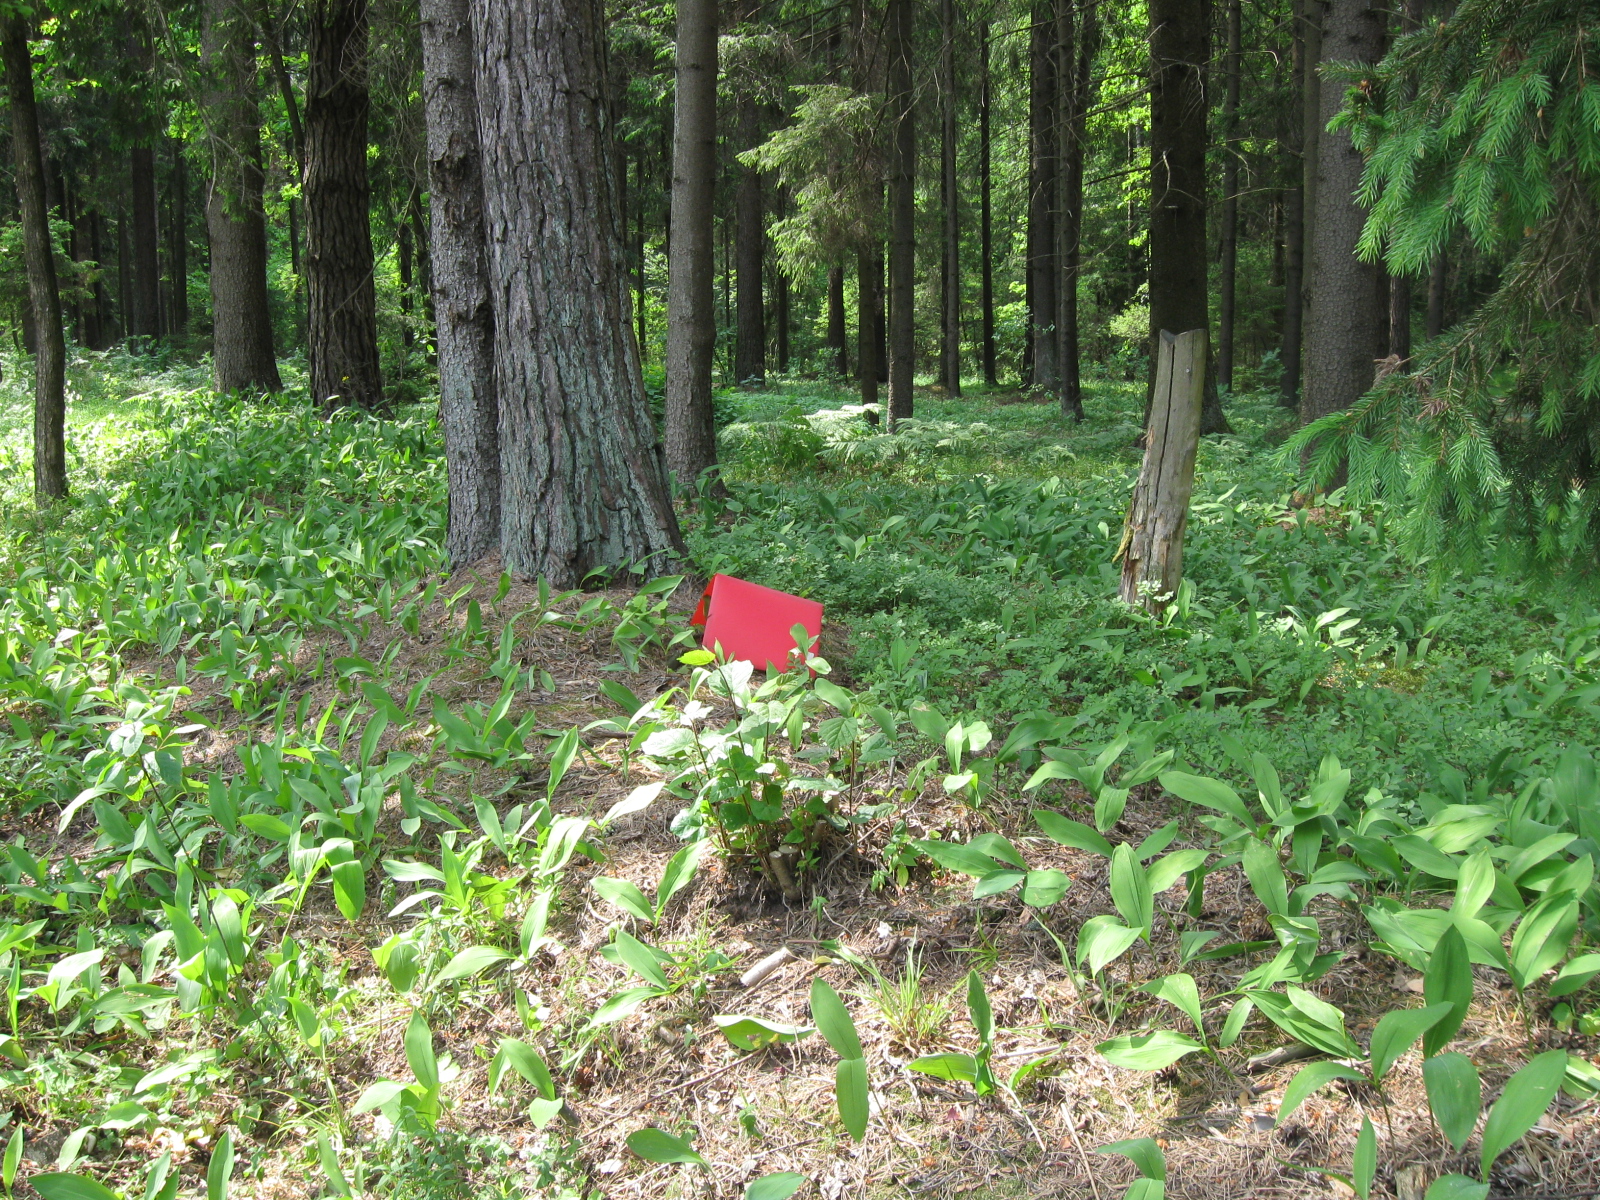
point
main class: Woodland
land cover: Spruce dominated coniferous woodland
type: hemiboreal forest and nemoral coniferous forest and mixed broadleaved-coniferous forest
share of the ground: > 75 %
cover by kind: coniferous forest trees 85 %, herbaceous plants 10 %, unconsolidated bare surface 5 %
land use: Forestry
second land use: Sport
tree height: > 5 m
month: June
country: LT
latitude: 54.9433
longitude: 23.9684
